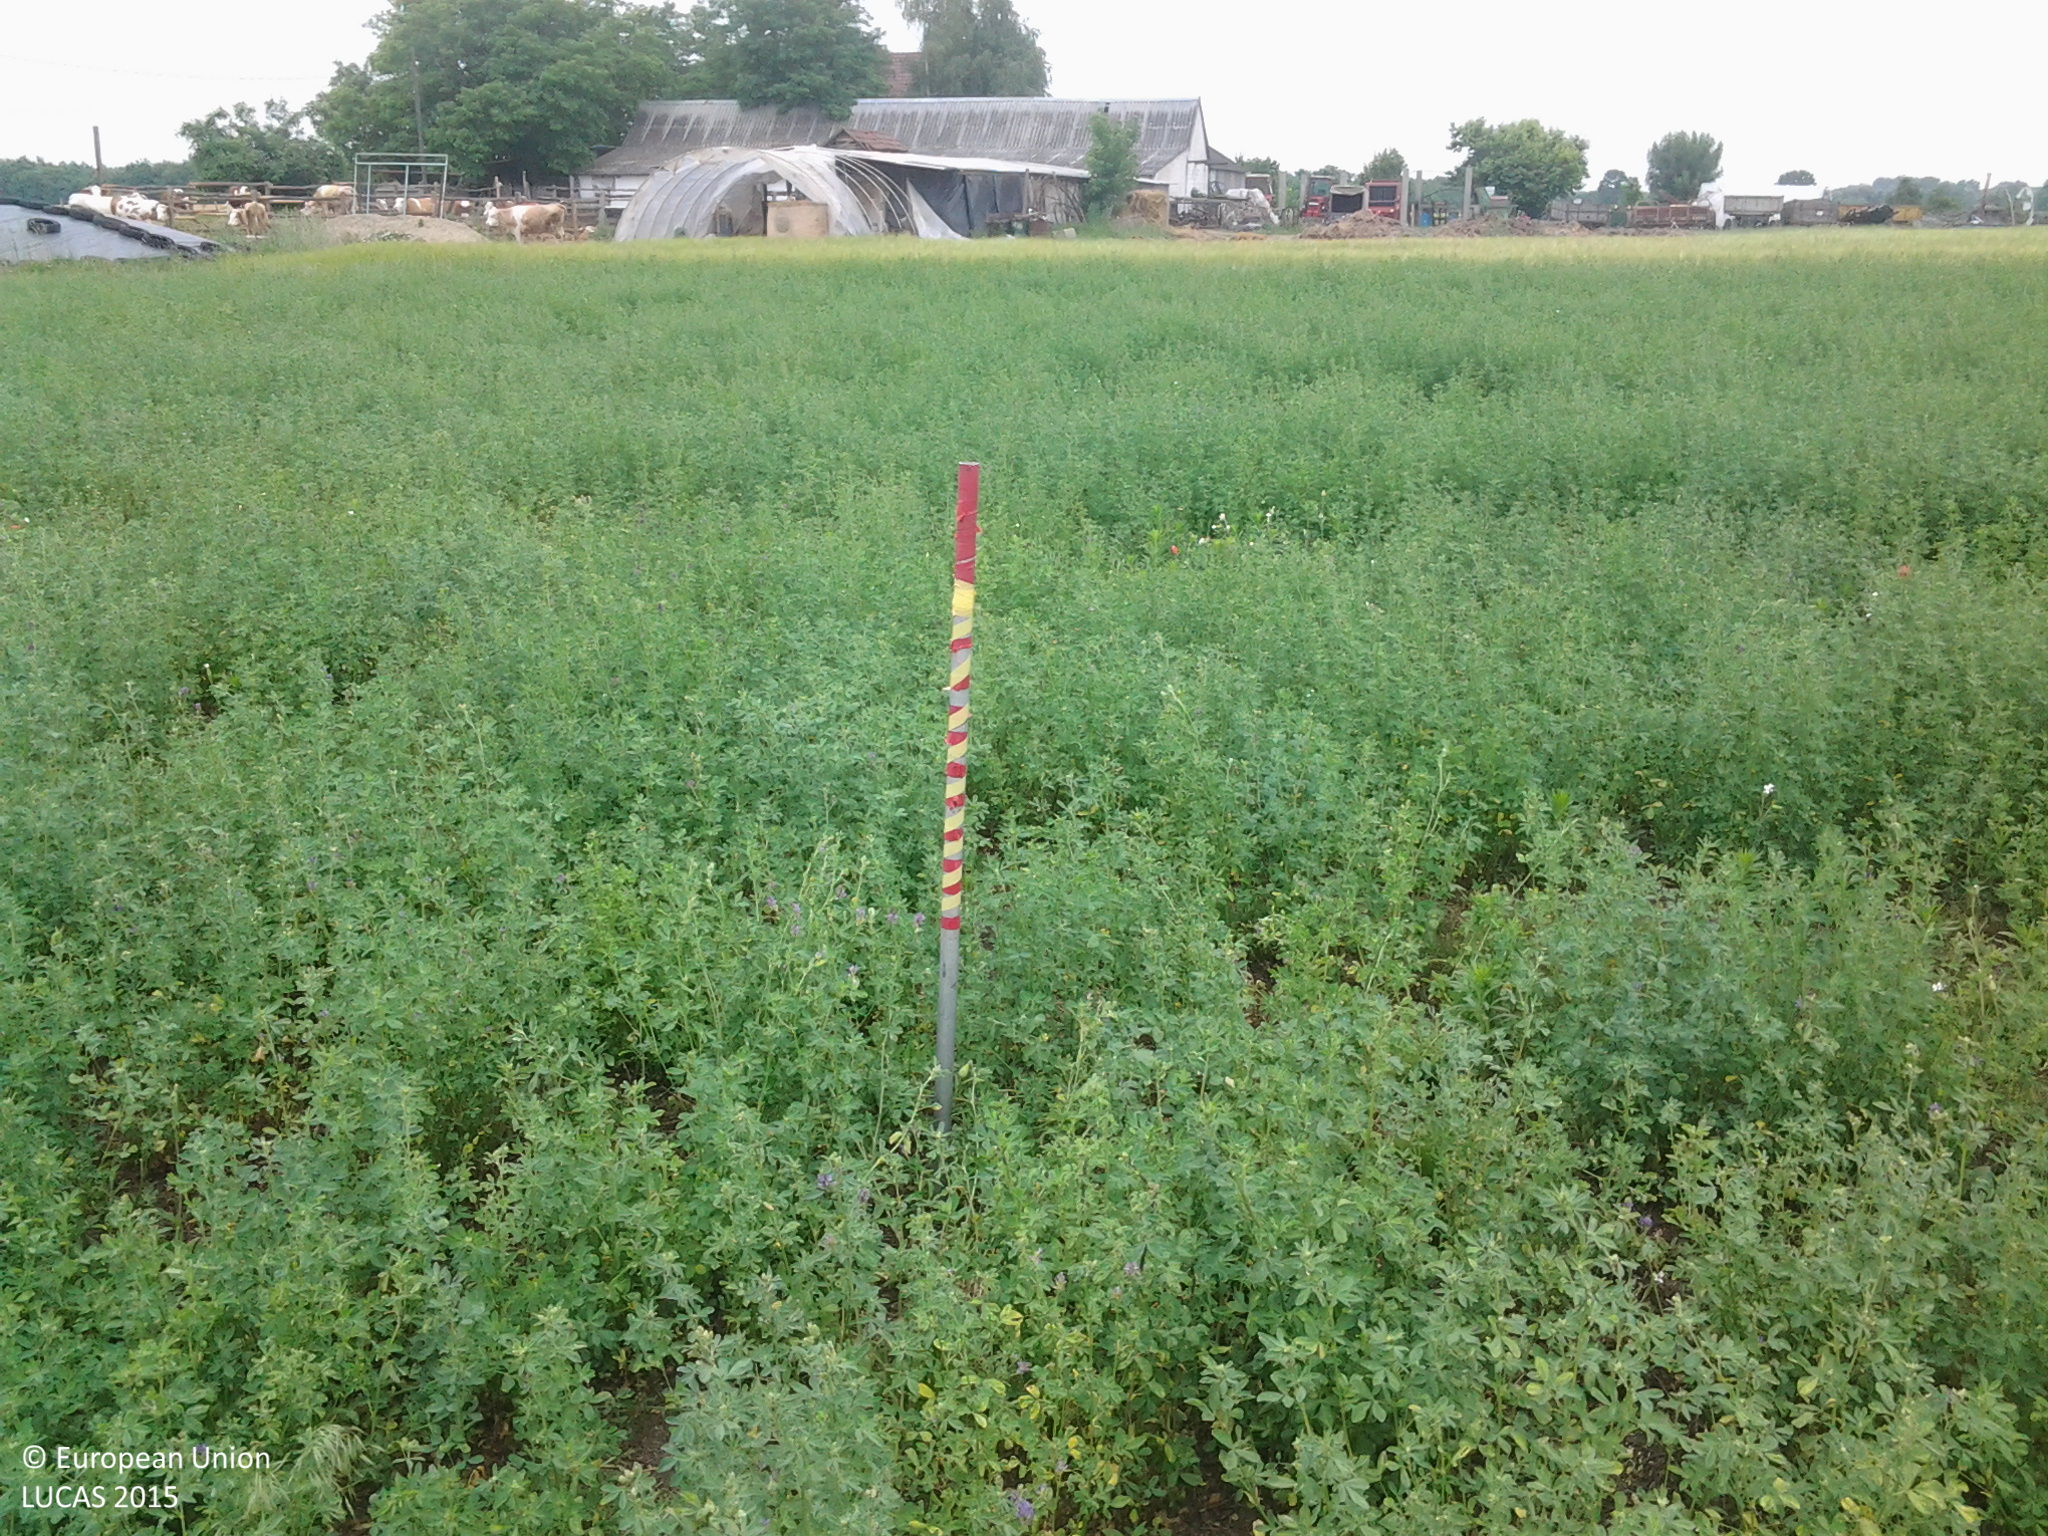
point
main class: Cropland
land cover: Lucerne
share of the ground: > 75 %
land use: Agriculture (excluding fallow land and kitchen gardens)
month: June
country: HU
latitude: 47.0008
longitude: 19.6608
